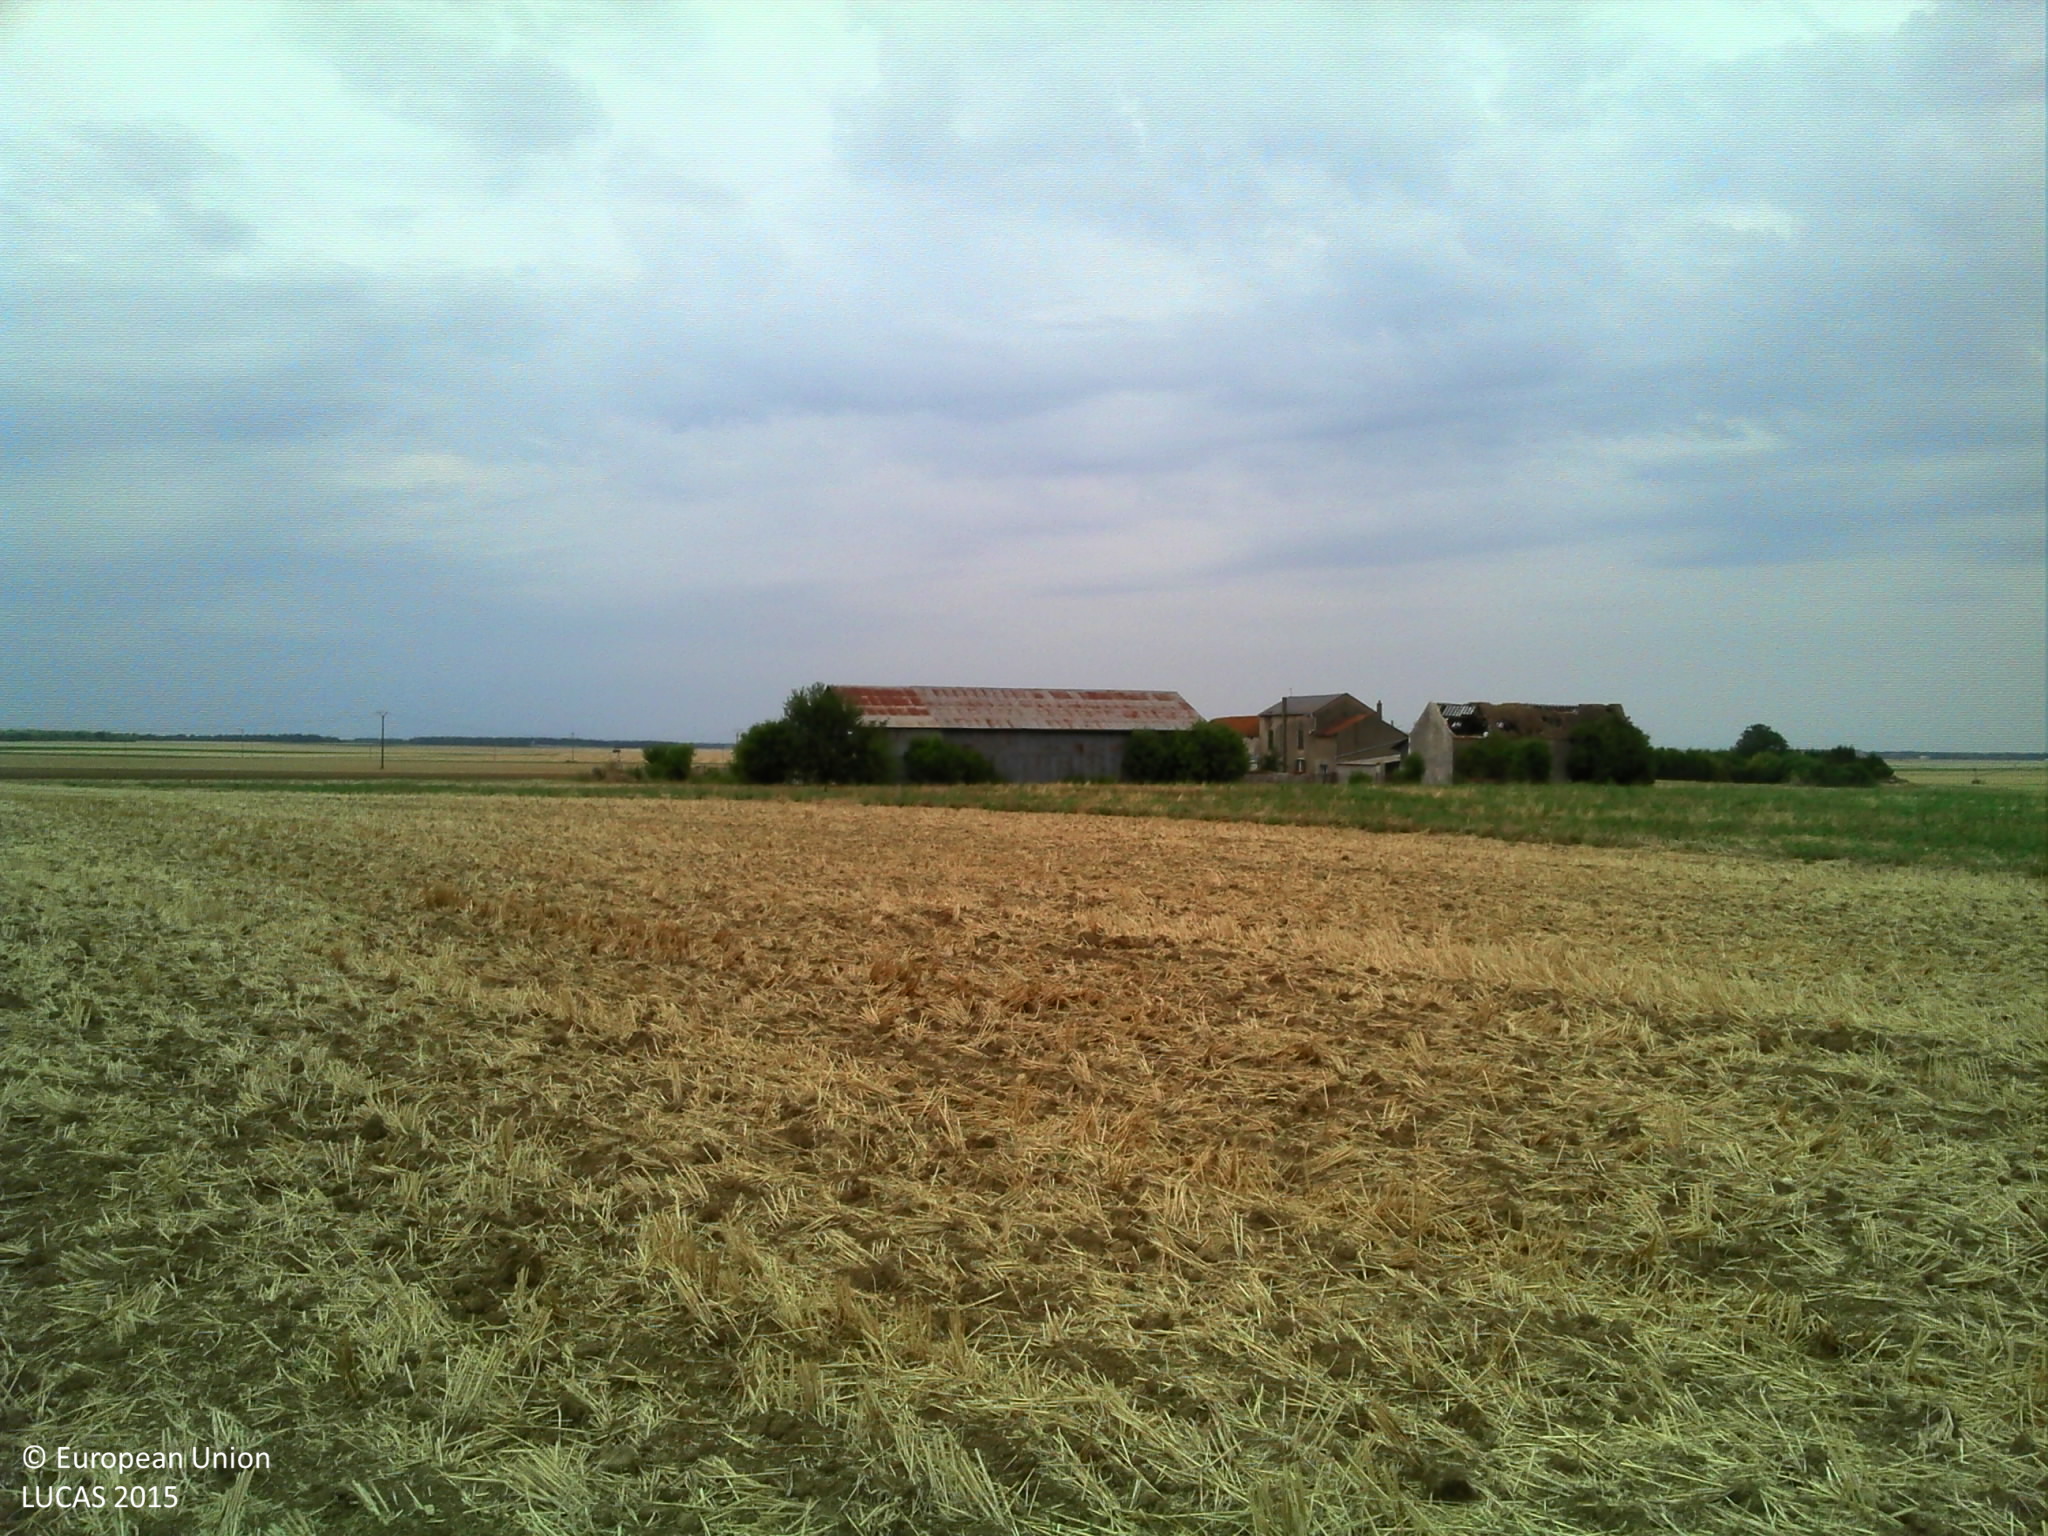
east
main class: Cropland
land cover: Common wheat
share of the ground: > 75 %
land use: Agriculture (excluding fallow land and kitchen gardens)
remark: Harvested field
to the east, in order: Common wheat; Lucerne; Clovers; Grassland without tree/shrub cover; Artificial constructions in urban areas; Grassland without tree/shrub cover; Fences; Grassland without tree/shrub cover; Fences; Grass margins; Paved roads, cycling and walking lanes; Grass margins; Other bare soil
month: August
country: FR
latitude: 48.1525
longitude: 2.5569
